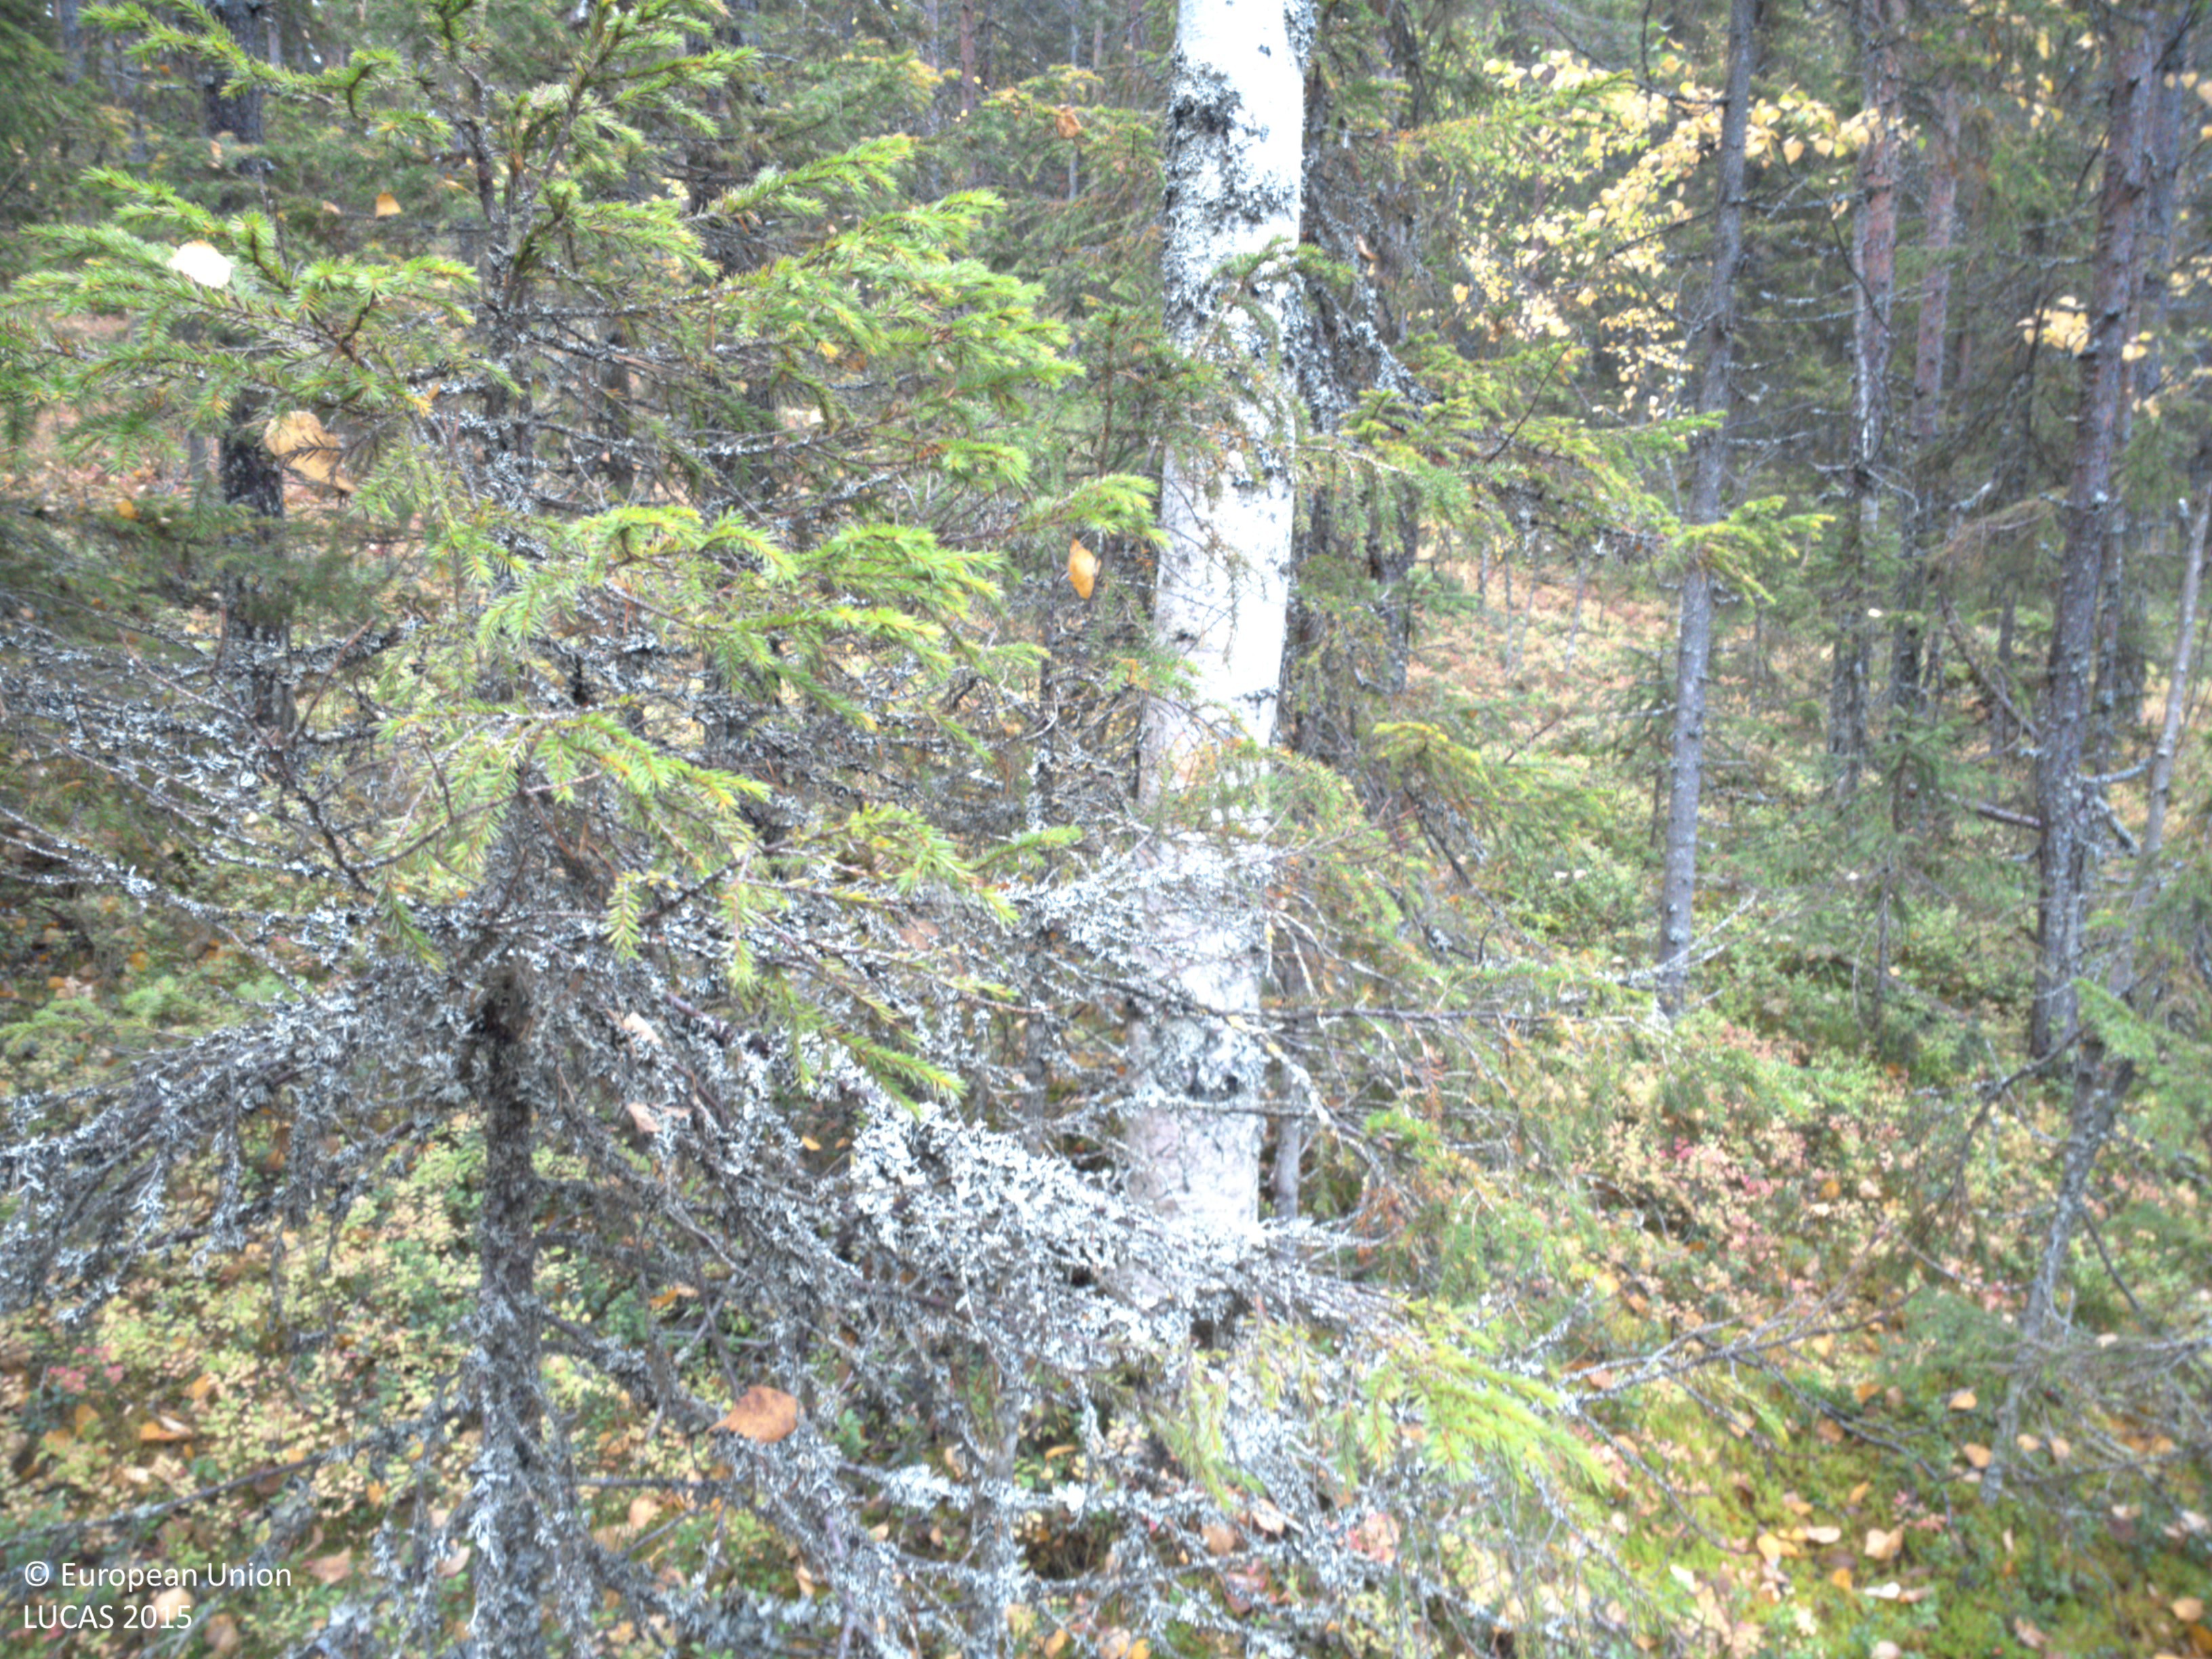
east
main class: Woodland
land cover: Other coniferous woodland
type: boreal forest
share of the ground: > 75 %
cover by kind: coniferous forest trees 75 %, broadleaved forest trees 10 %, shrubs 5 %, herbaceous plants 5 %, lichens and mosses 5 %
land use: Forestry
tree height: > 5 m
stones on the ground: < 10 %
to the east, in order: Other coniferous woodland; Spruce dominated coniferous woodland; Other coniferous woodland; Other mixed woodland; Spruce dominated coniferous woodland; Tracks; Pine dominated mixed woodland; Other mixed woodland; Shrubland with sparse tree cover; Other mixed woodland; Pine dominated mixed woodland
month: September
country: SE
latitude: 64.8761
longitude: 18.8953
